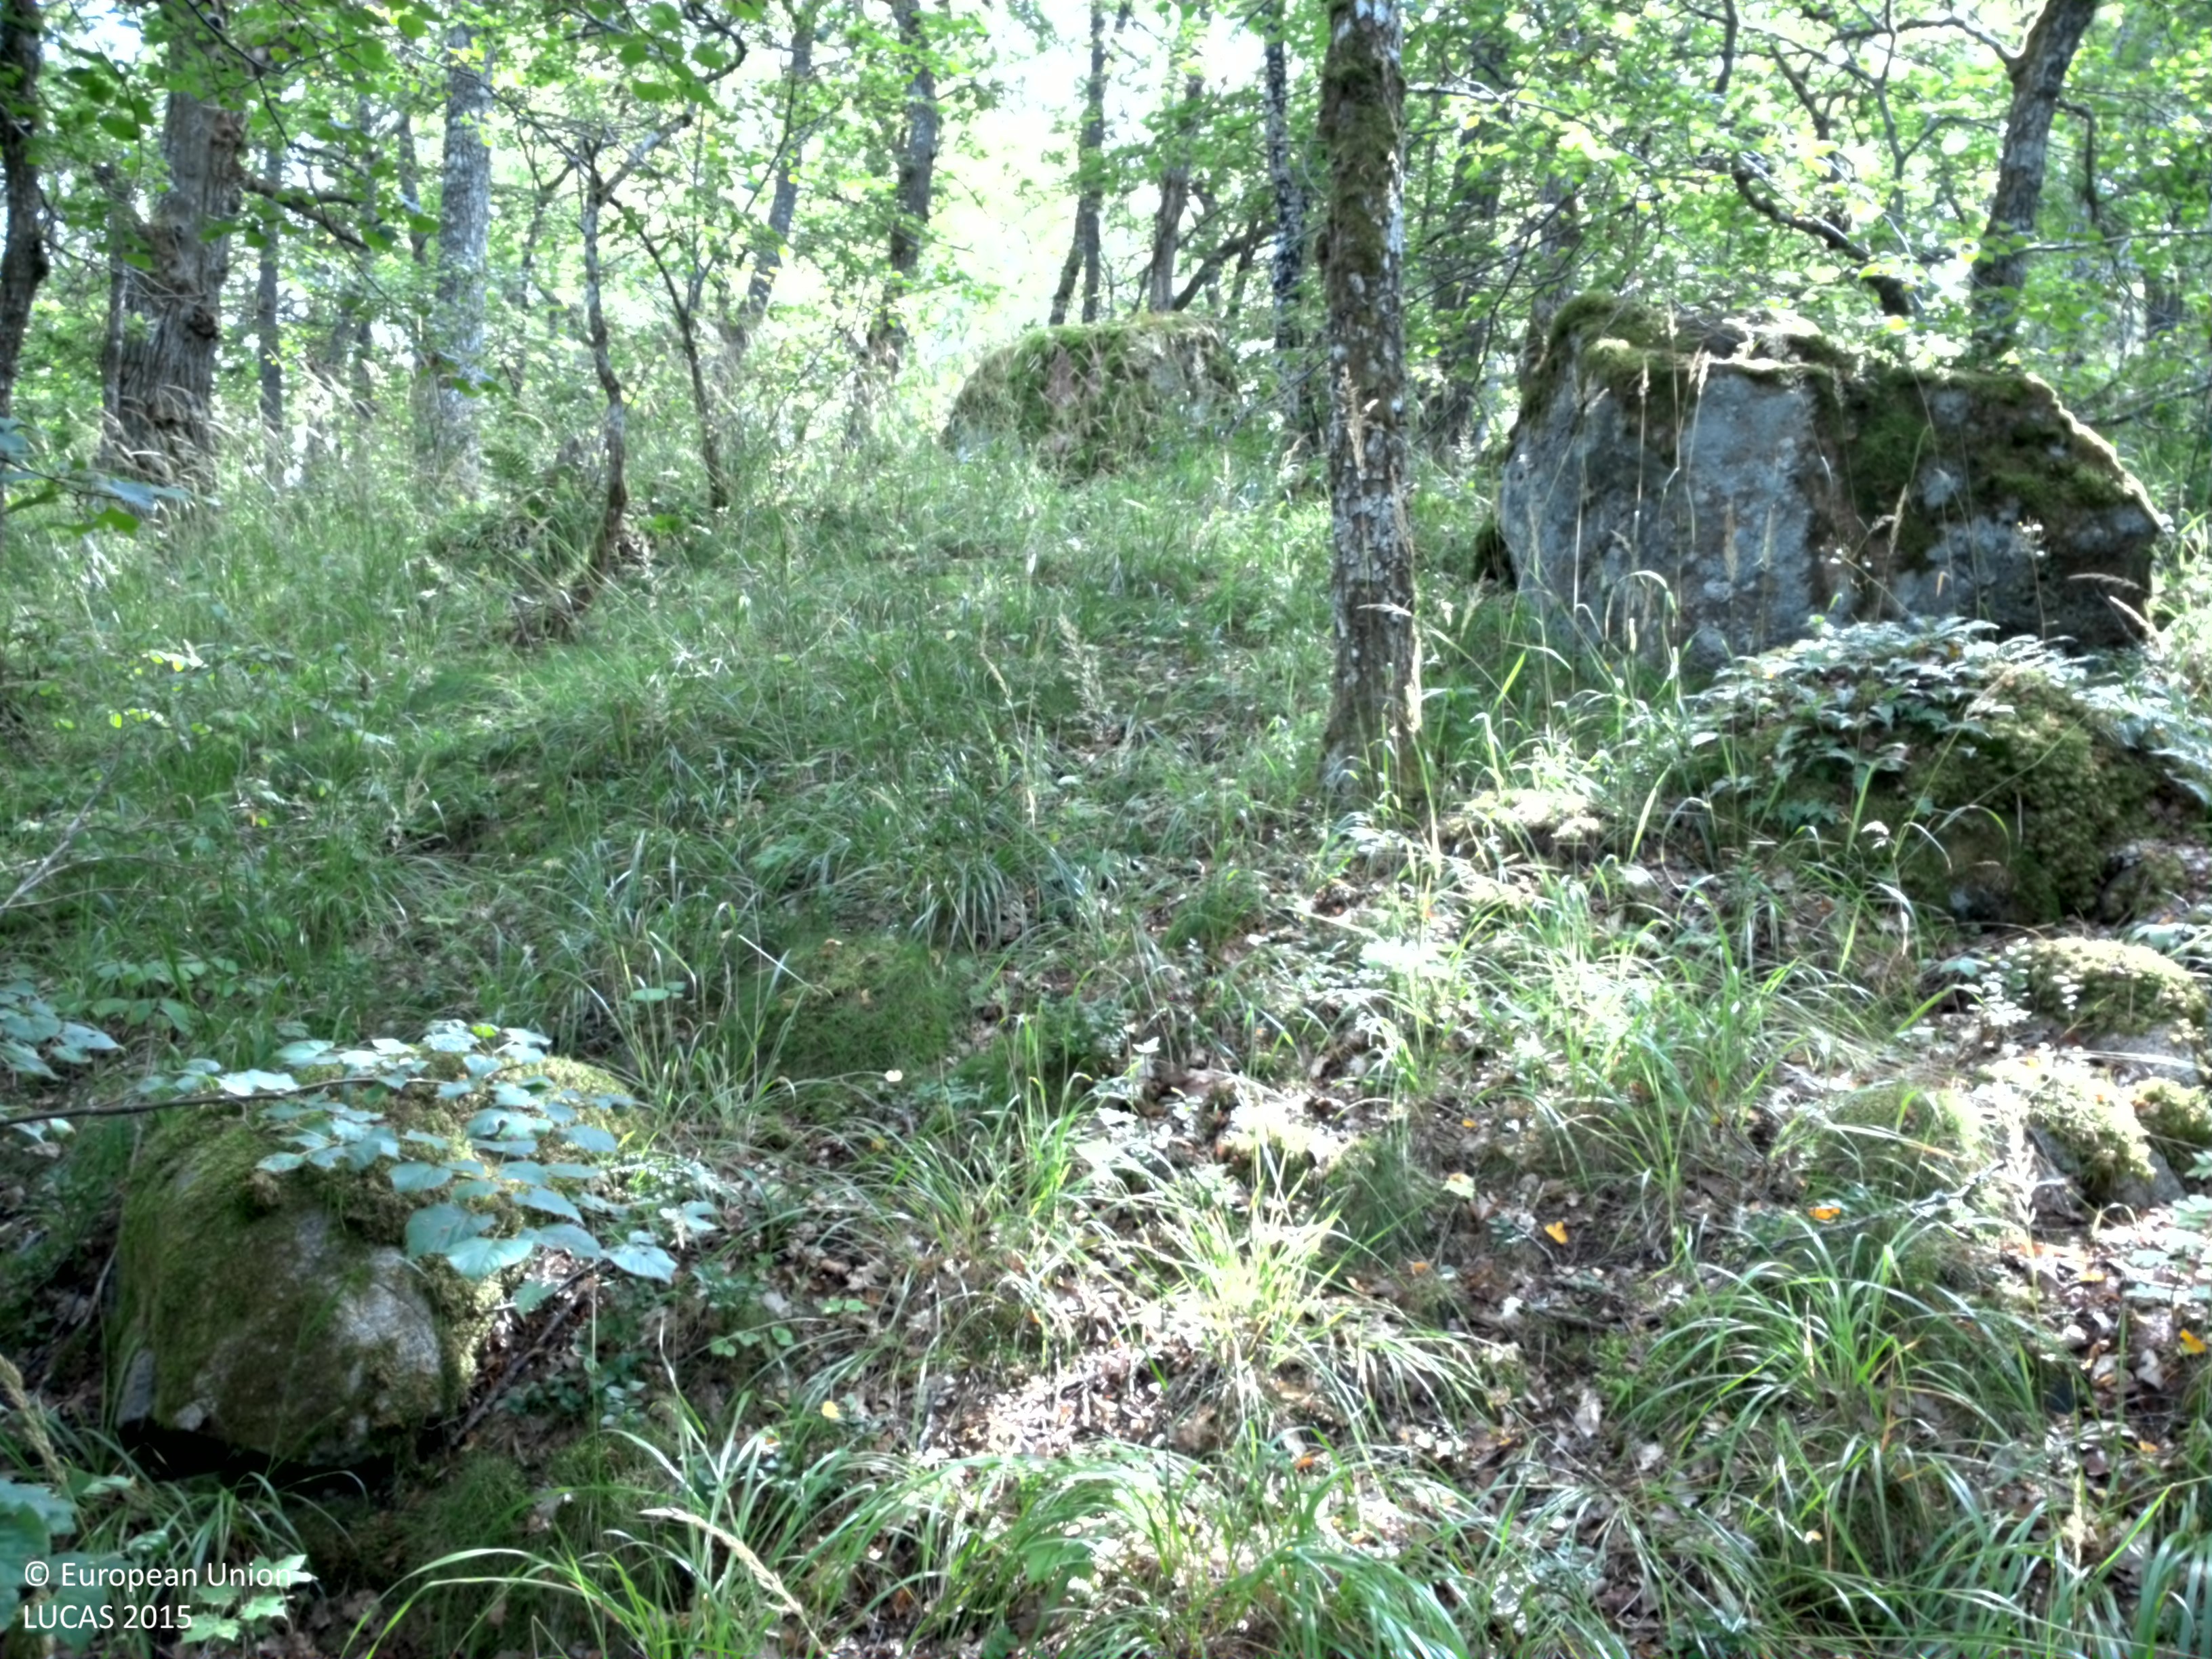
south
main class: Woodland
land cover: Broadleaved woodland
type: hemiboreal forest and nemoral coniferous forest and mixed broadleaved-coniferous forest
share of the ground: > 75 %
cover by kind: broadleaved forest trees 80 %, herbaceous plants 15 %, shrubs 5 %
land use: Forestry
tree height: > 5 m
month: August
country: SE
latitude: 59.8820
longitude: 17.9820
